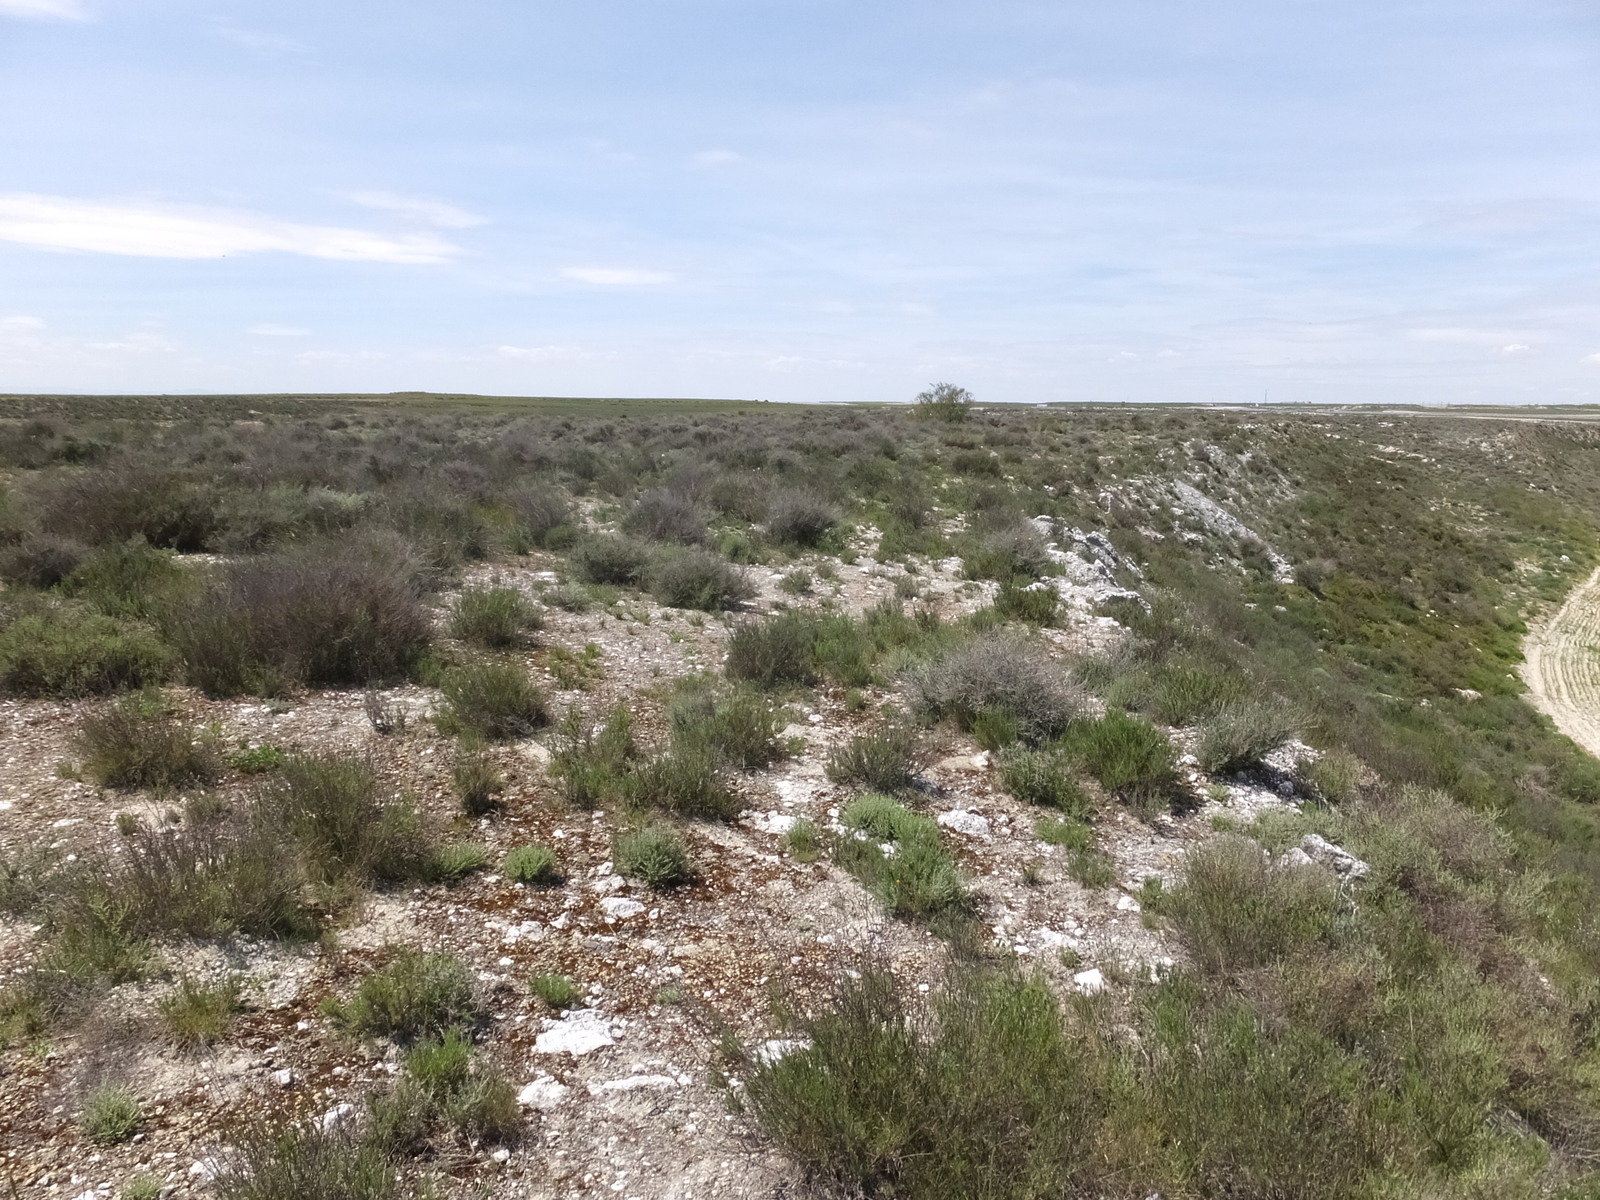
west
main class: Shrubland
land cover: Shrubland without tree cover
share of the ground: > 75 %
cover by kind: shrubs 100 %
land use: Semi-natural and natural areas not in use
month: April
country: ES
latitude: 41.5202
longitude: -0.1896
